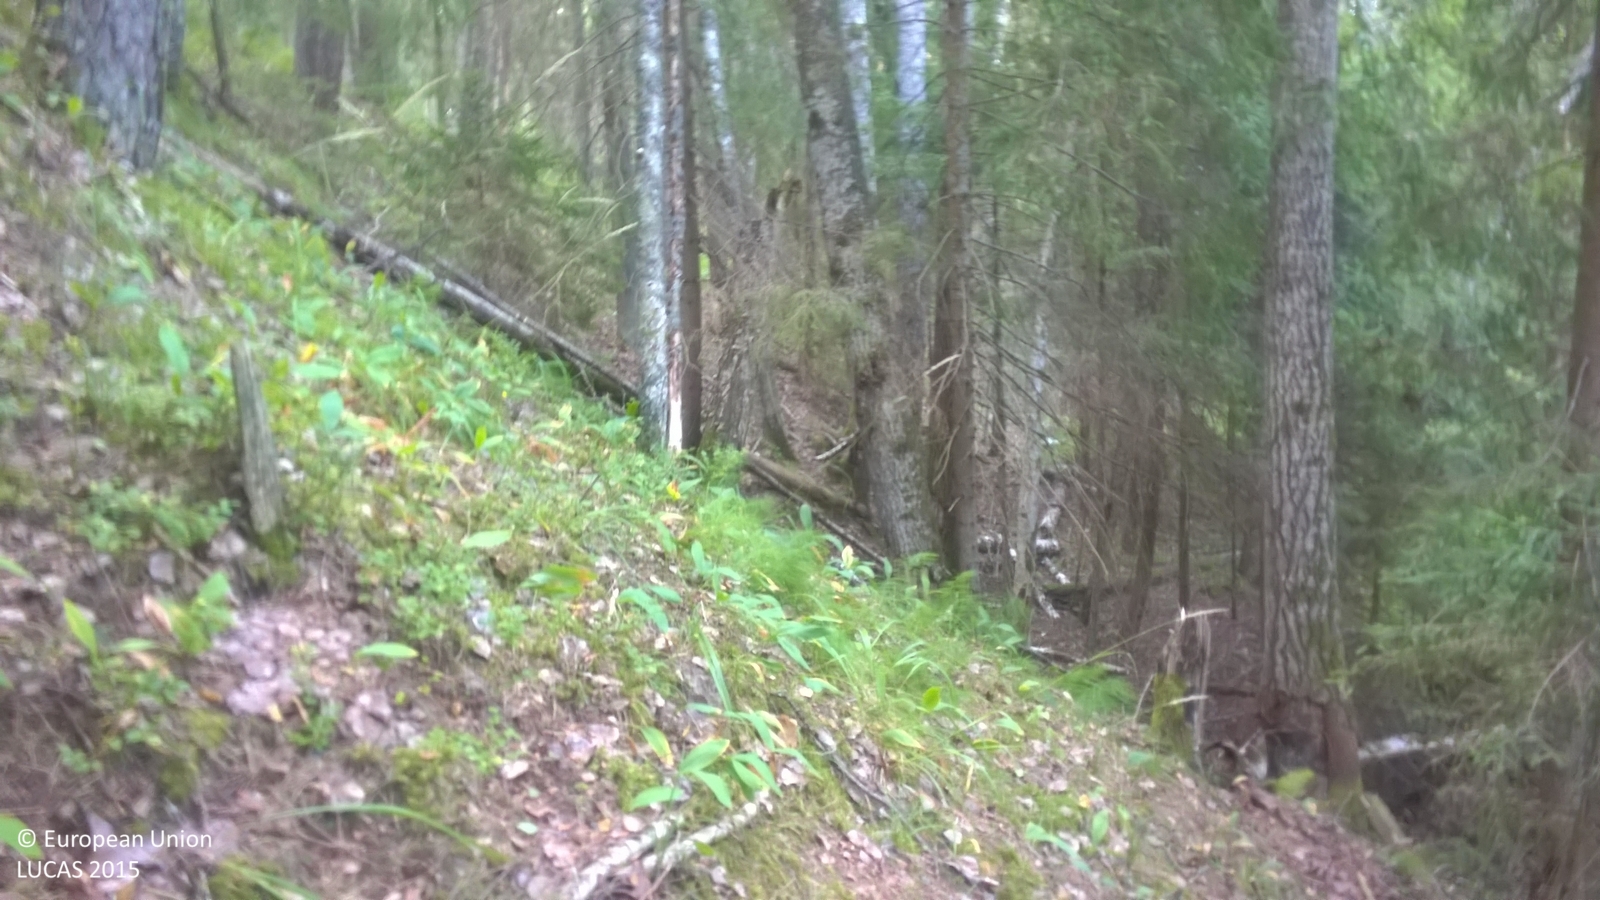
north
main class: Woodland
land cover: Other mixed woodland
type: hemiboreal forest and nemoral coniferous forest and mixed broadleaved-coniferous forest
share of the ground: > 75 %
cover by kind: coniferous forest trees 50 %, broadleaved forest trees 35 %, herbaceous plants 5 %, lichens and mosses 5 %, unconsolidated bare surface 5 %
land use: Forestry
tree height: > 5 m
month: August
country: LV
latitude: 57.7046
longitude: 26.0541
